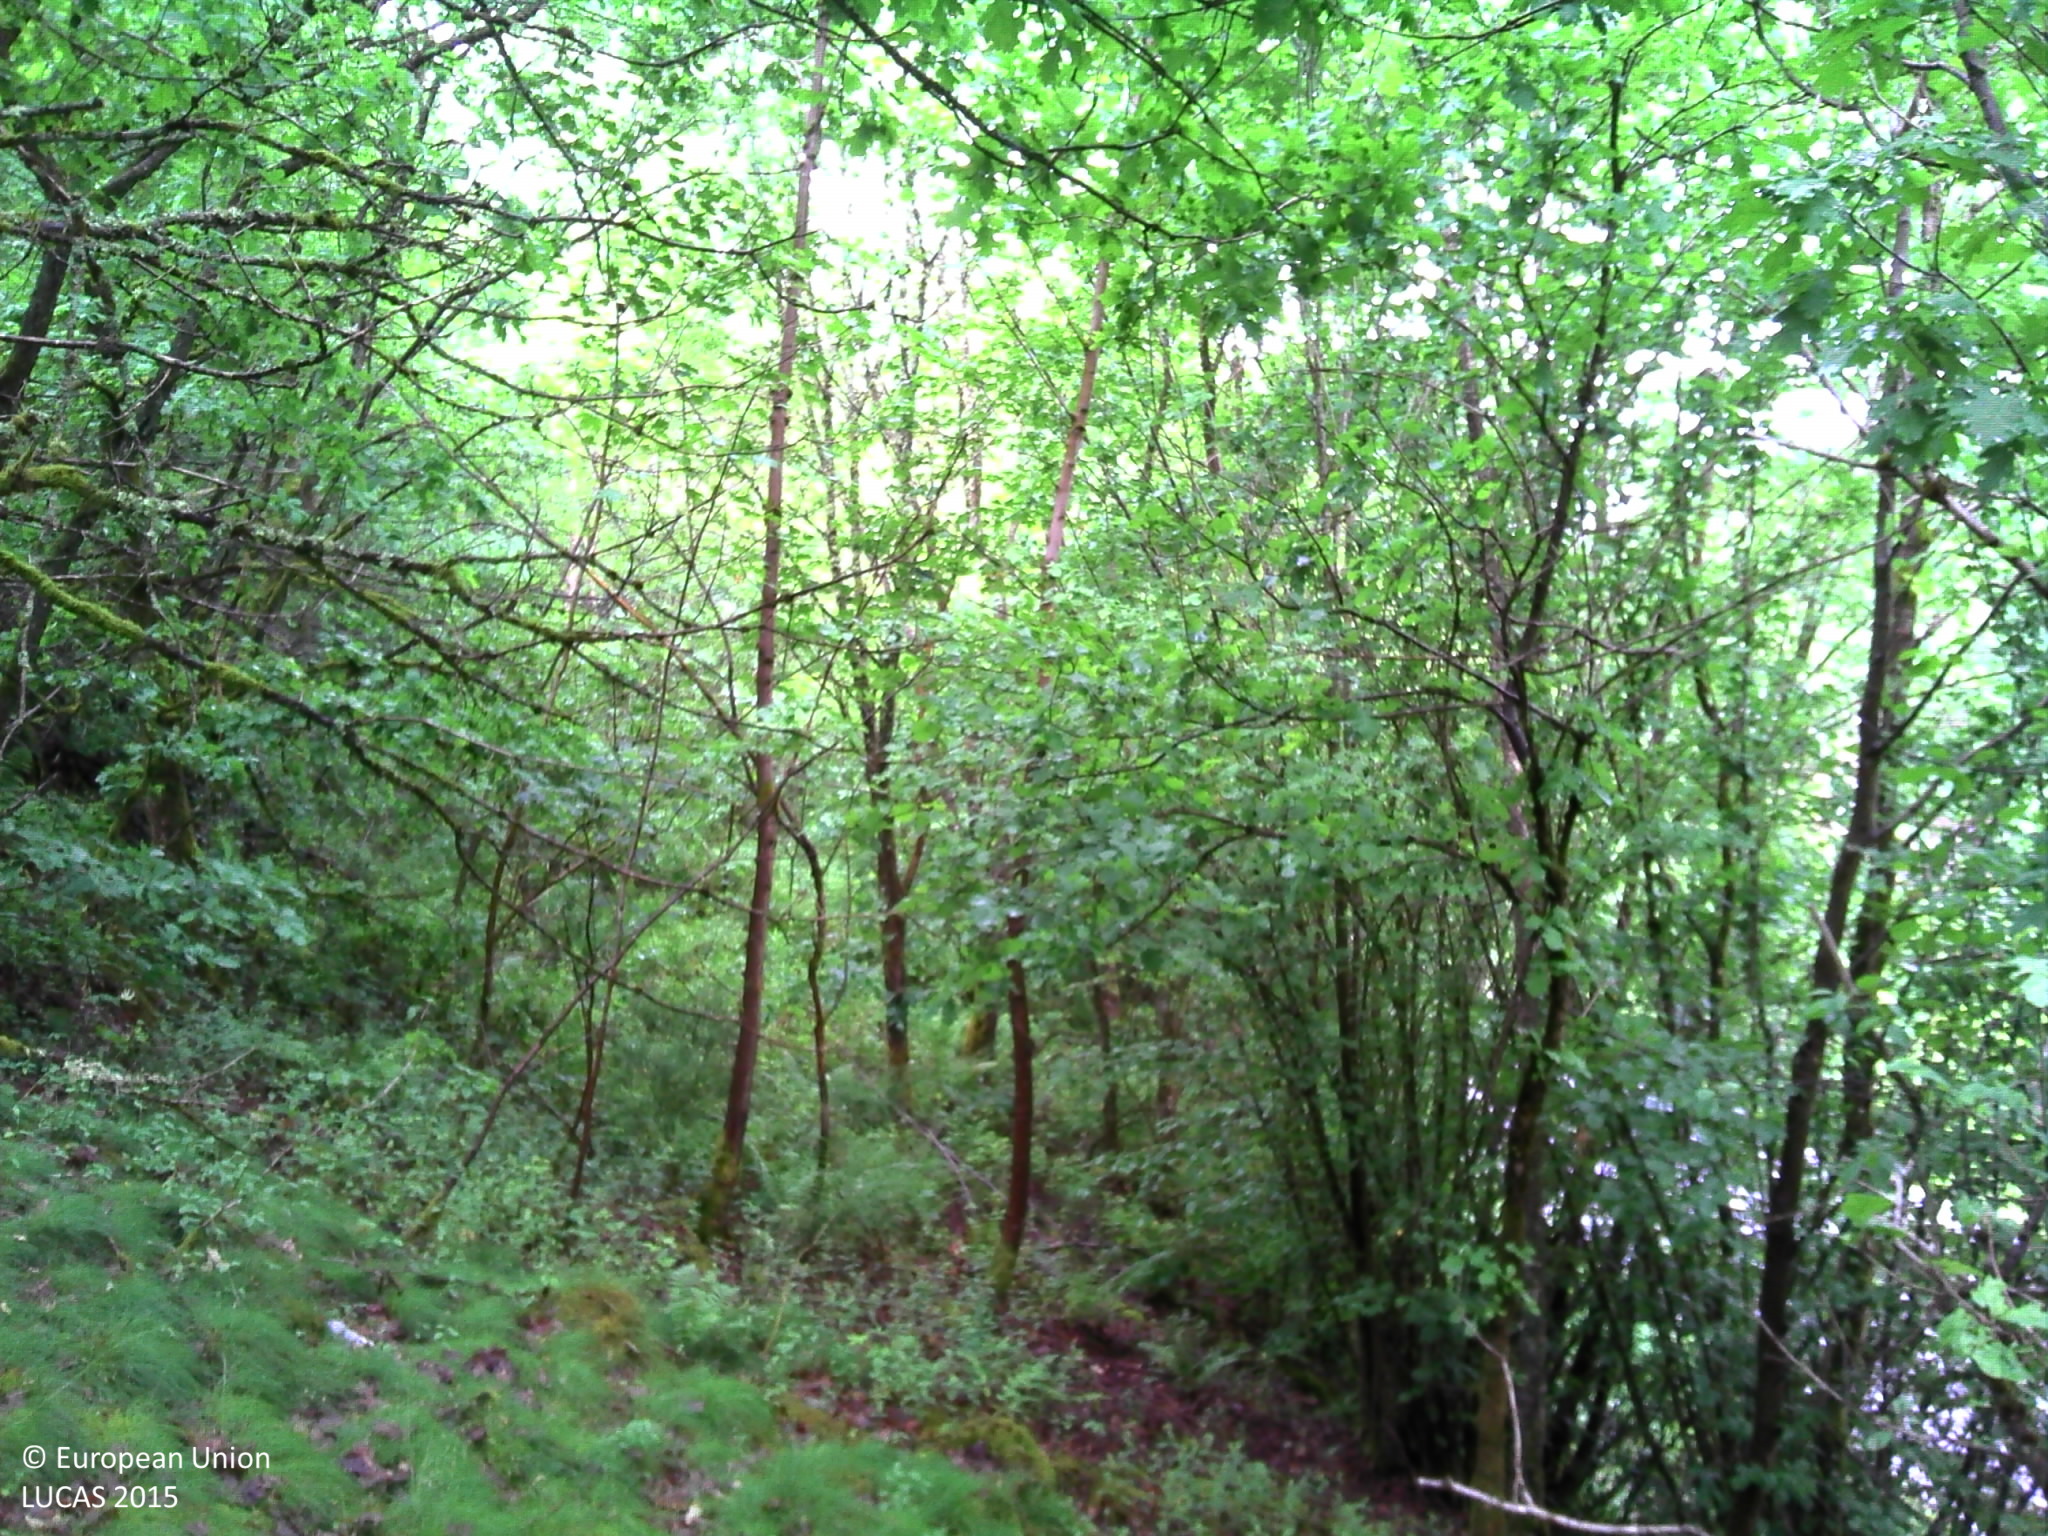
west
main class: Woodland
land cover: Broadleaved woodland
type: acidophilous oak and oak-birch forest
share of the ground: > 75 %
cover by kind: broadleaved forest trees 95 %, herbaceous plants 5 %
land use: Forestry
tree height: > 5 m
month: June
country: BE
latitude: 50.1867
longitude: 5.5305
